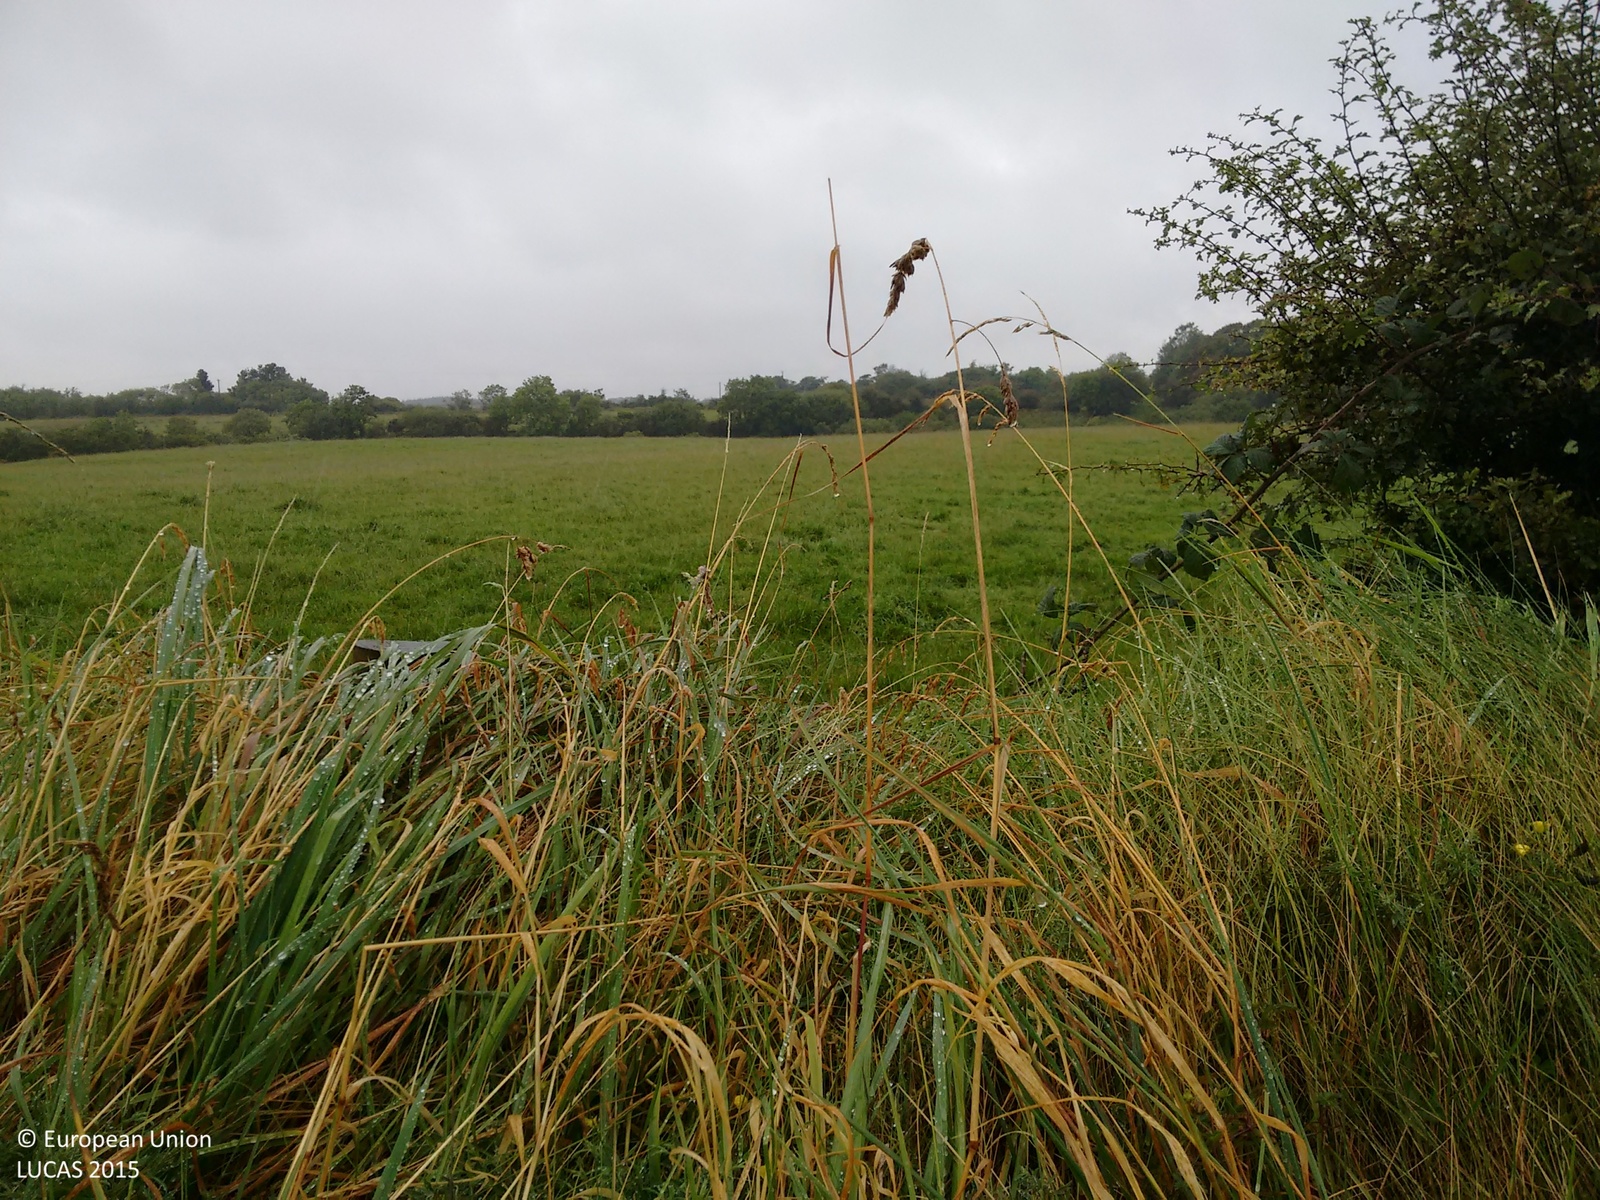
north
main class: Grassland
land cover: Grassland without tree/shrub cover
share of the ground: > 75 %
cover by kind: herbaceous plants 100 %
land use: Agriculture (excluding fallow land and kitchen gardens)
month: September
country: IE
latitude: 54.1489
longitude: -9.3798
